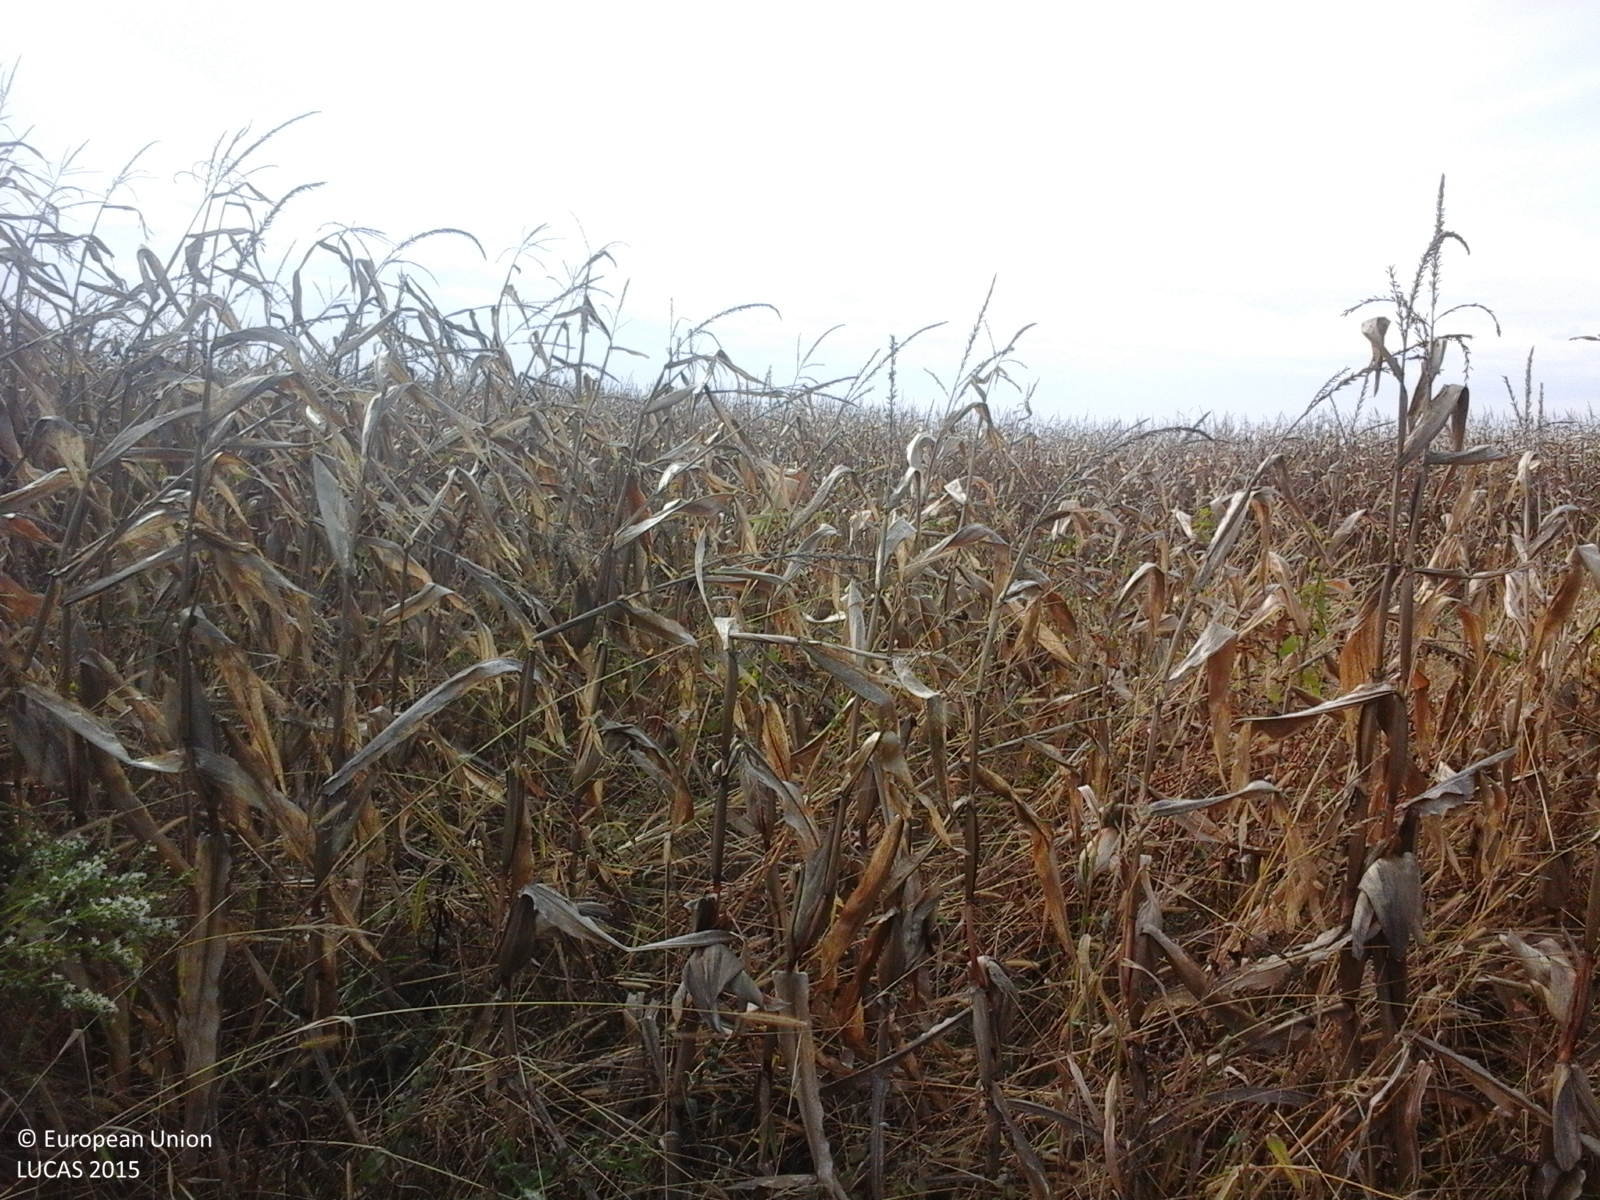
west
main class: Grassland
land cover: Spontaneously vegetated surfaces
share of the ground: > 75 %
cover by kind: herbaceous plants 100 %
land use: Fallow land
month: October
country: RO
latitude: 45.8297
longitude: 25.0388
